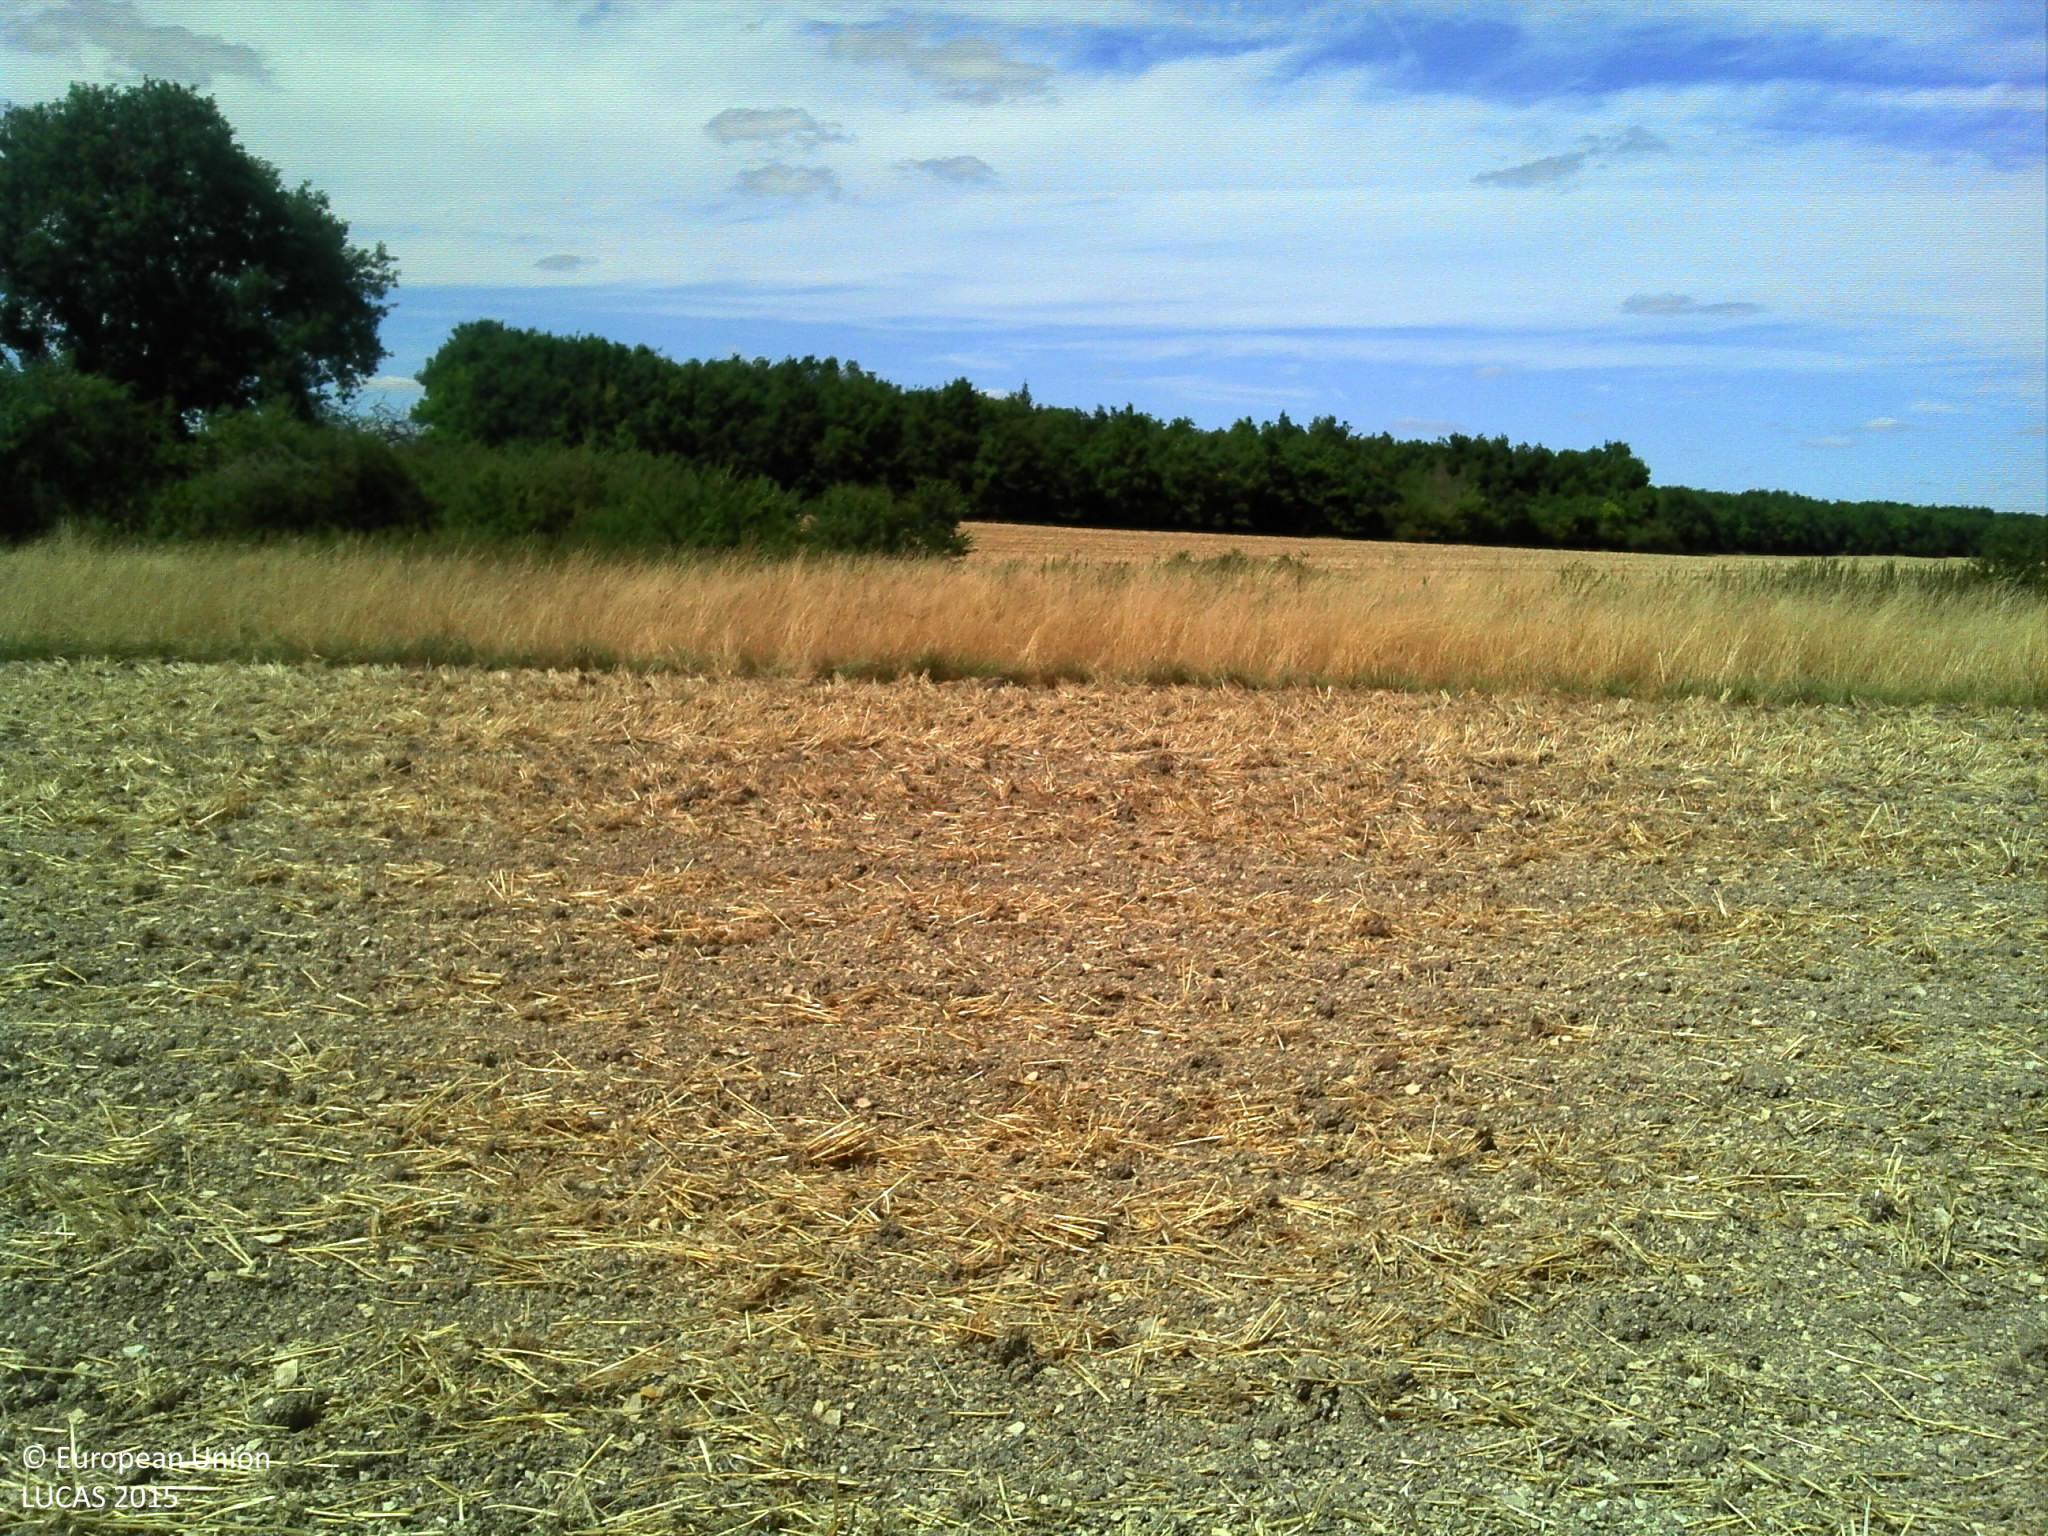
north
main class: Cropland
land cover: Barley
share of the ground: > 75 %
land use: Agriculture (excluding fallow land and kitchen gardens)
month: July
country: FR
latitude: 47.0183
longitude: 2.1112
